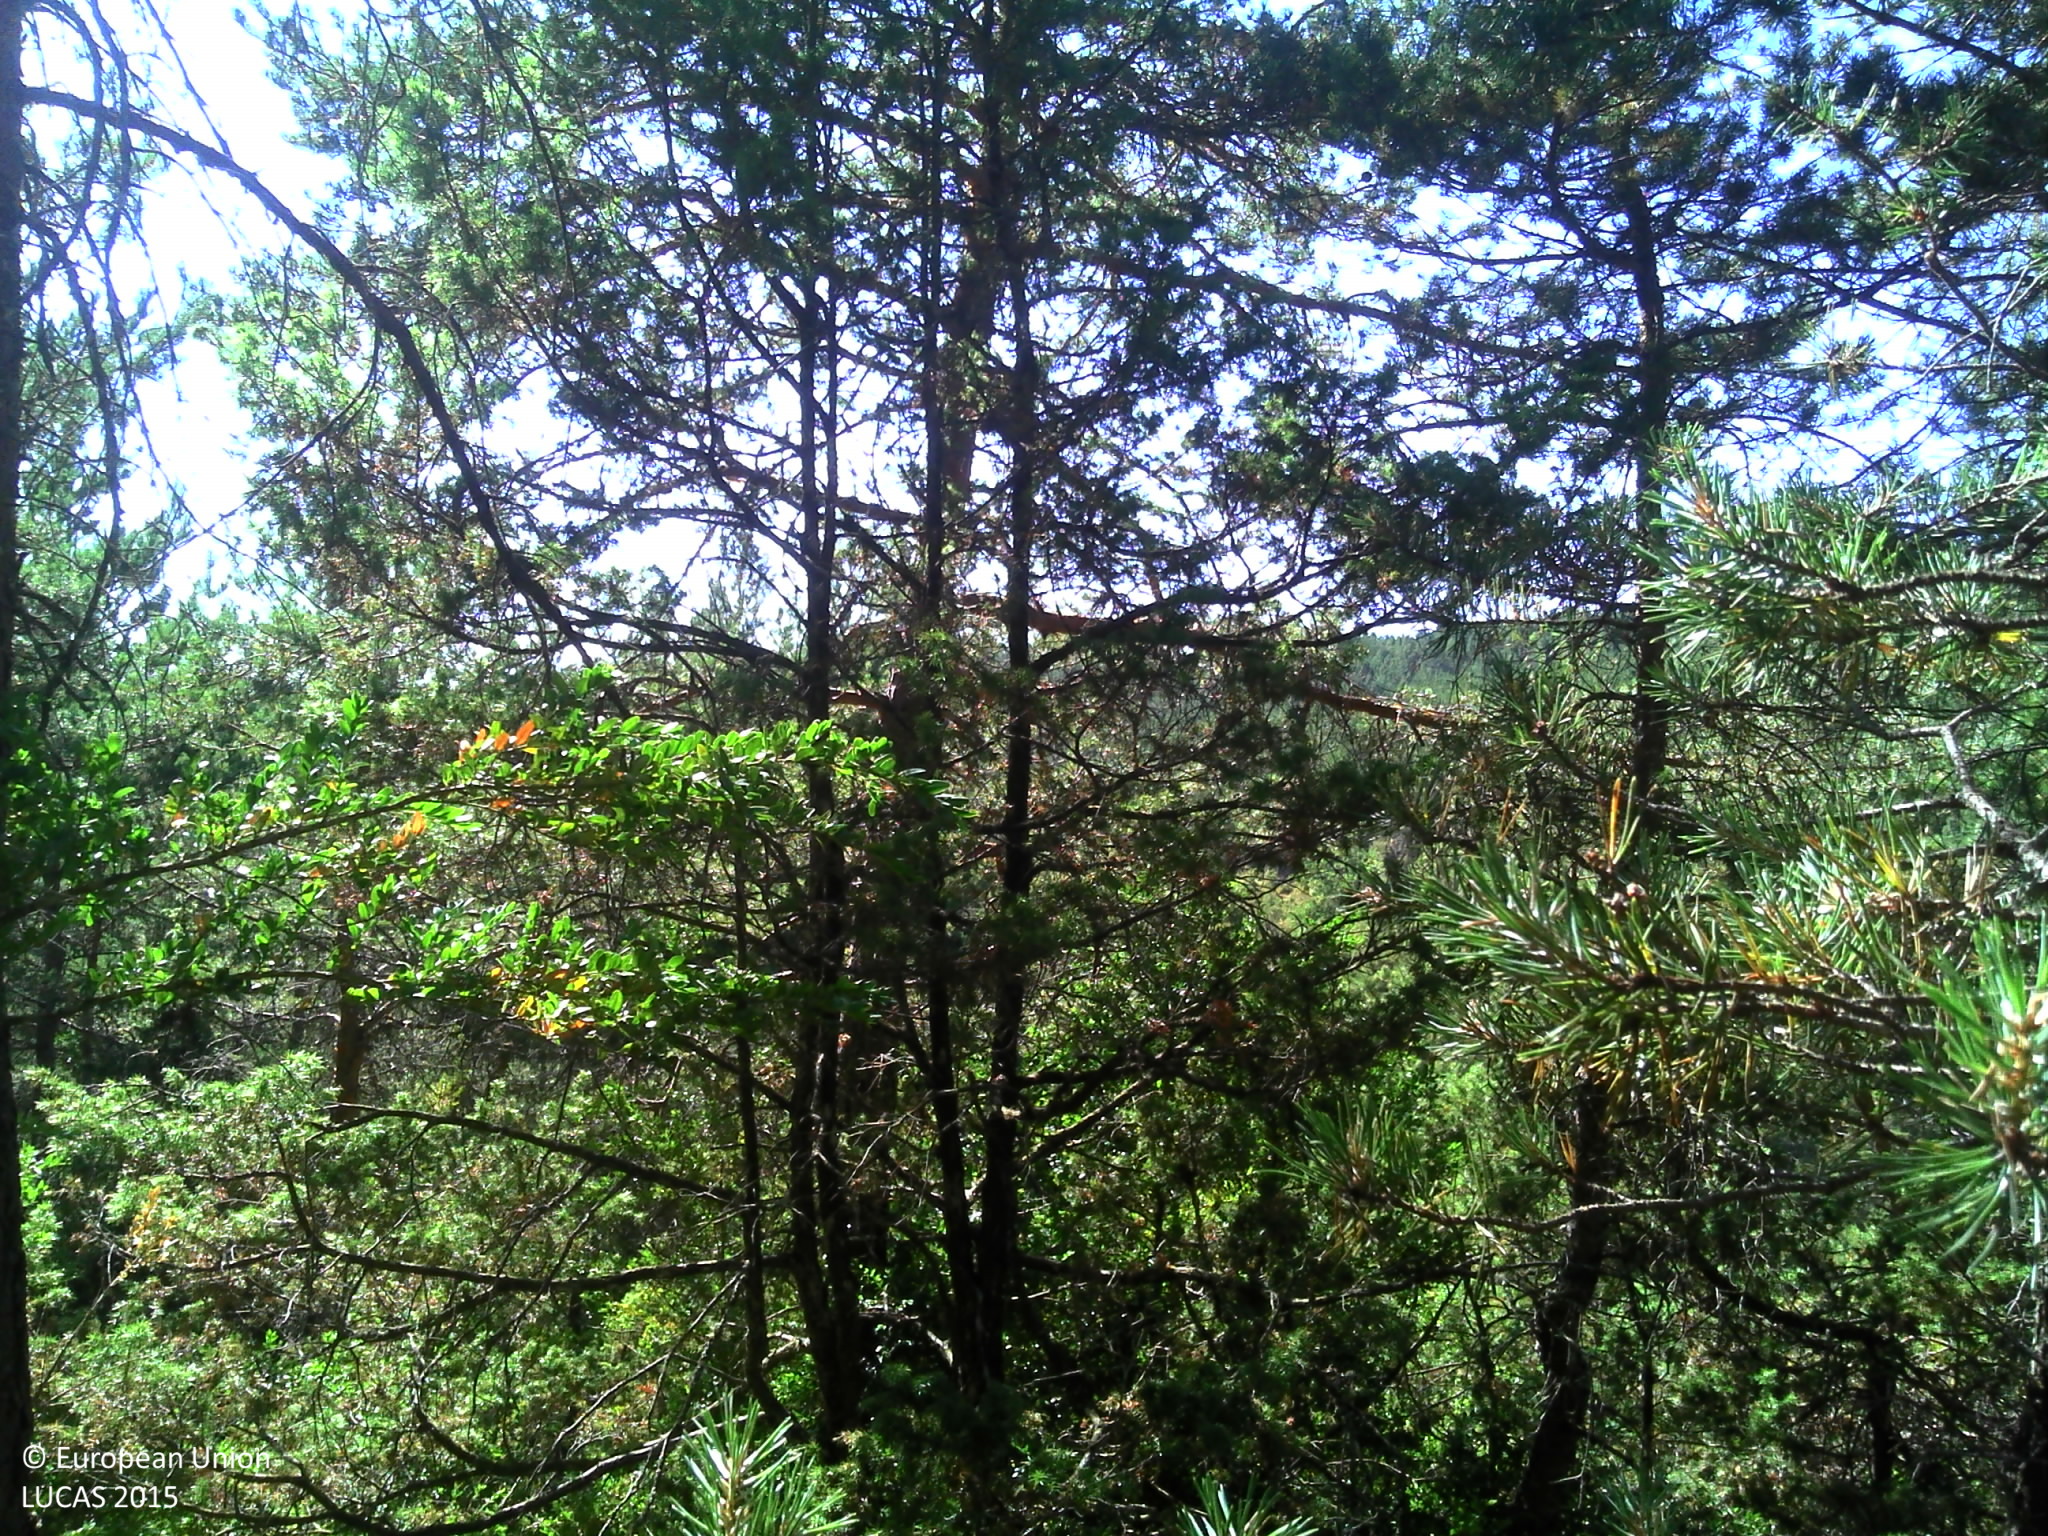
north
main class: Woodland
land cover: Pine dominated coniferous woodland
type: alpine coniferous forest
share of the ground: > 75 %
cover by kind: coniferous forest trees 75 %, shrubs 10 %, herbaceous plants 10 %, broadleaved forest trees 5 %
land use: Forestry
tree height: > 5 m
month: July
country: FR
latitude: 44.3670
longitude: 3.2667
